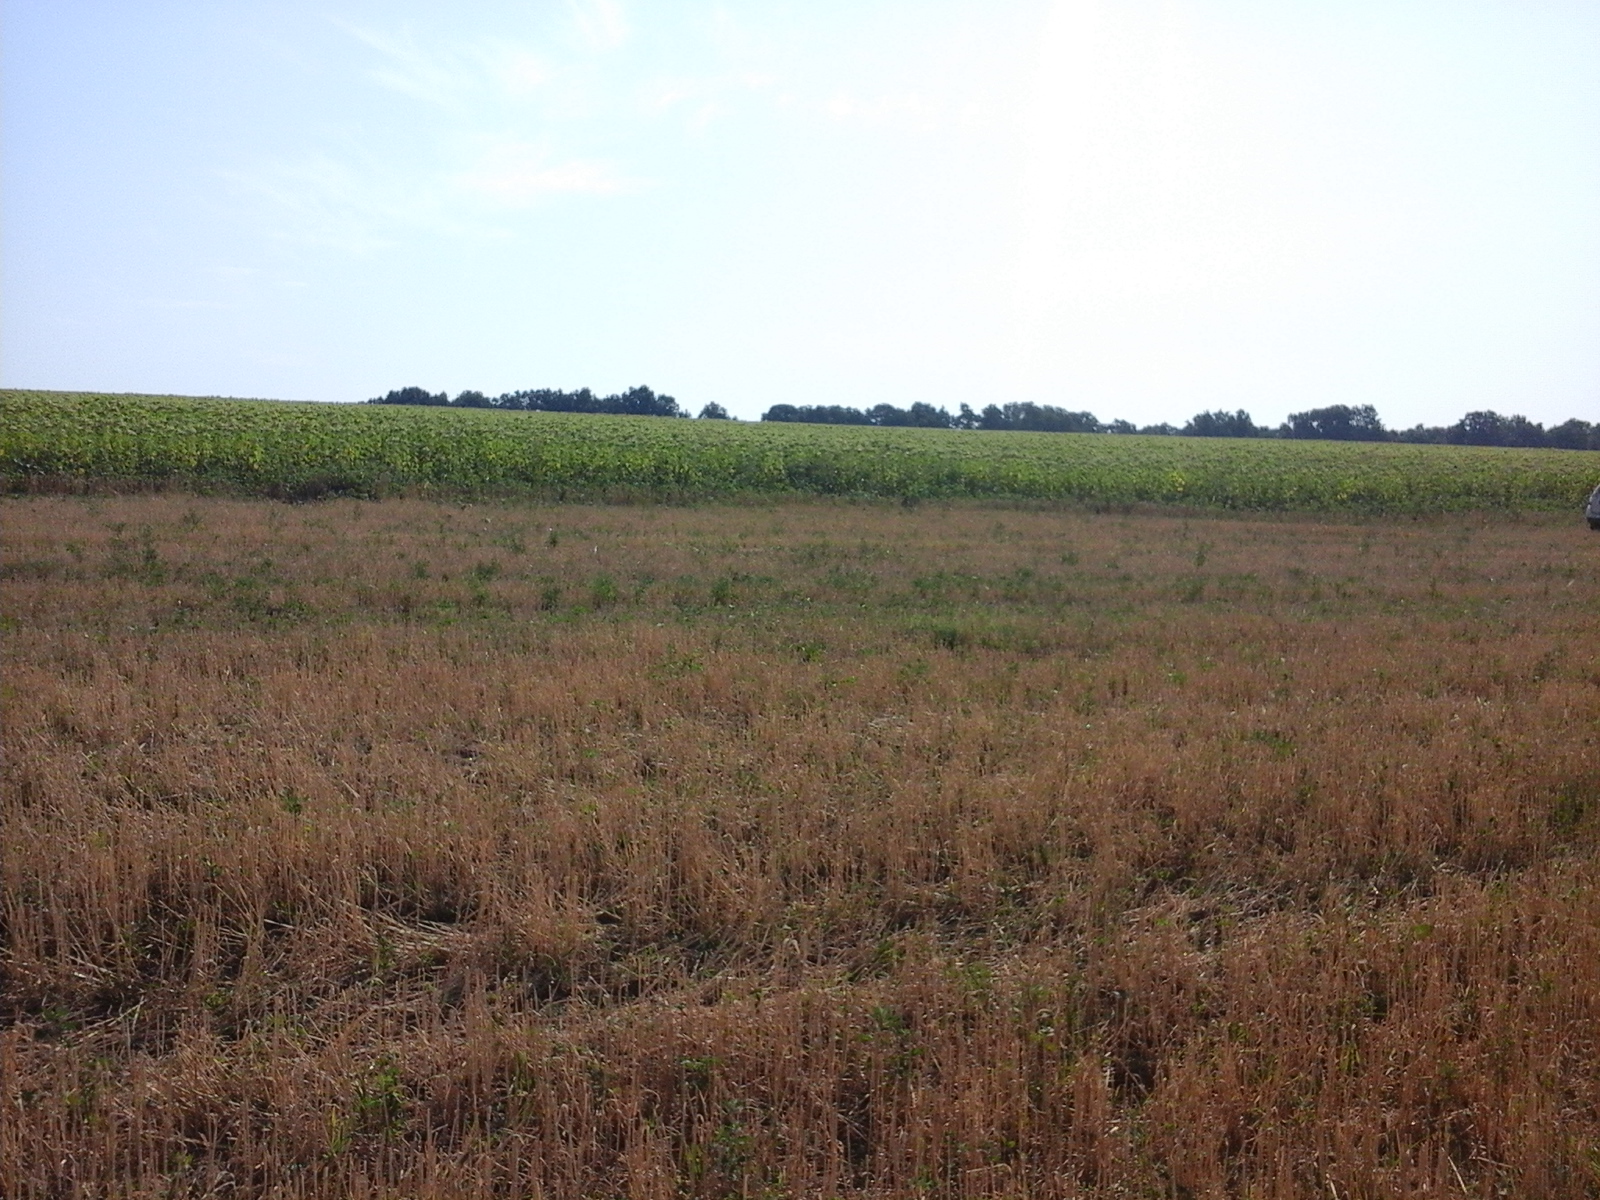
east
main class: Cropland
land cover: Common wheat
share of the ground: > 75 %
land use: Agriculture (excluding fallow land and kitchen gardens)
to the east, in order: Common wheat; Sunflower
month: August
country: RO
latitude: 45.8076
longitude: 27.5423
